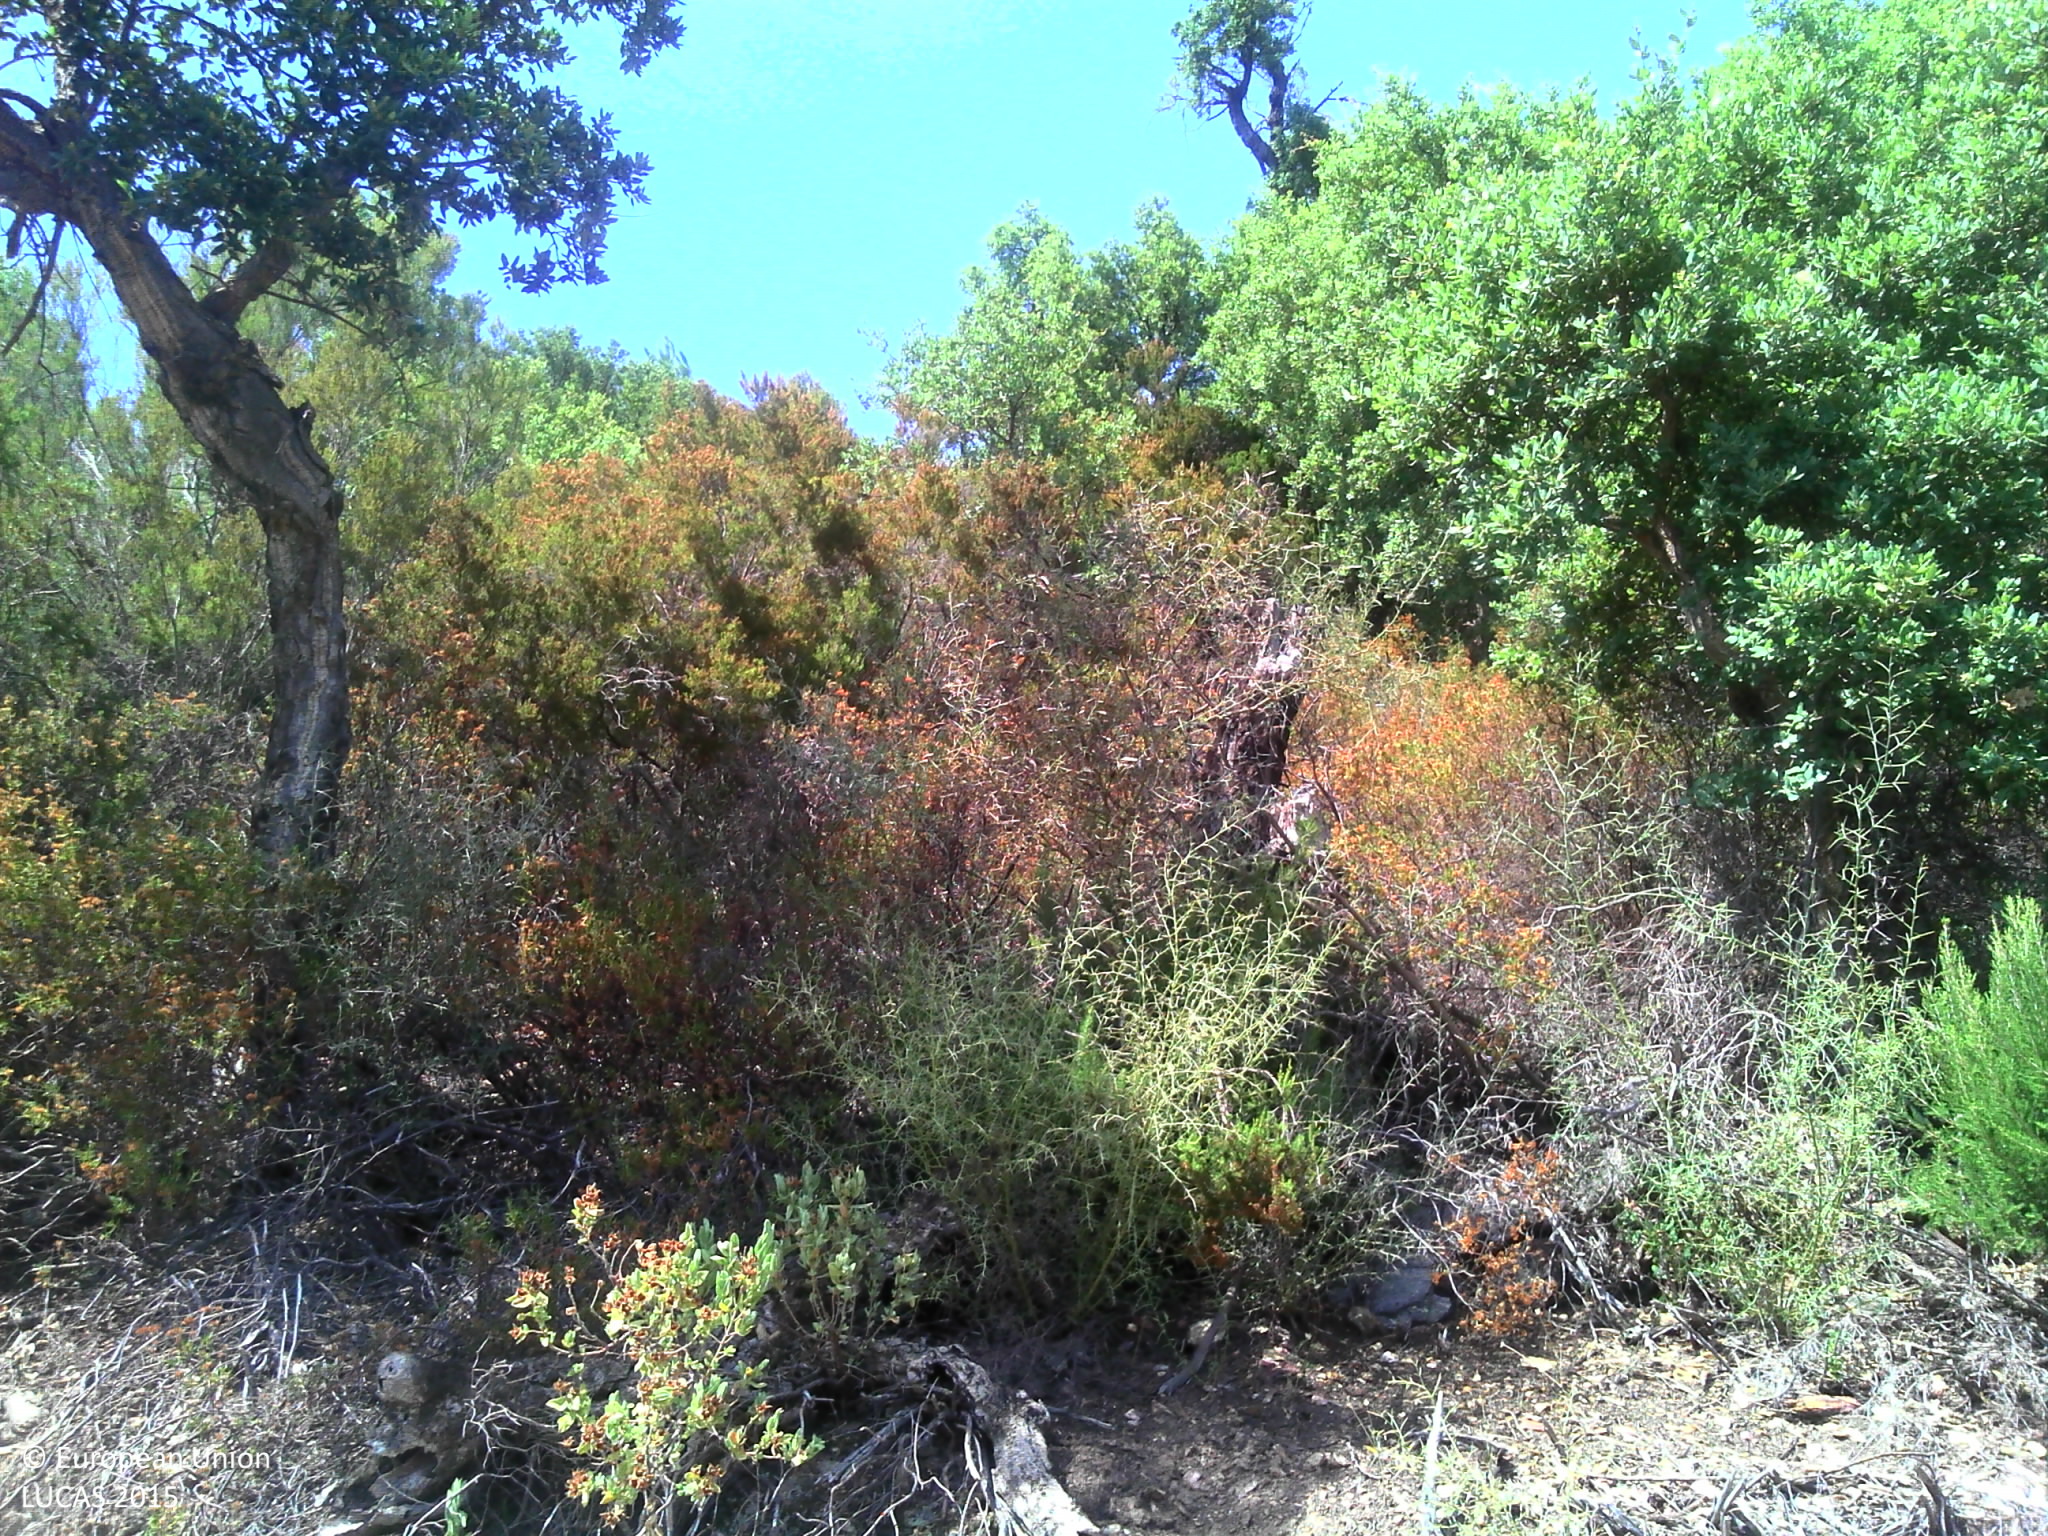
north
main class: Shrubland
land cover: Shrubland with sparse tree cover
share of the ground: > 75 %
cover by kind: shrubs 95 %, broadleaved forest trees 5 %
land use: Semi-natural and natural areas not in use
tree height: > 5 m
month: July
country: FR
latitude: 43.2011
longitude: 6.3051
